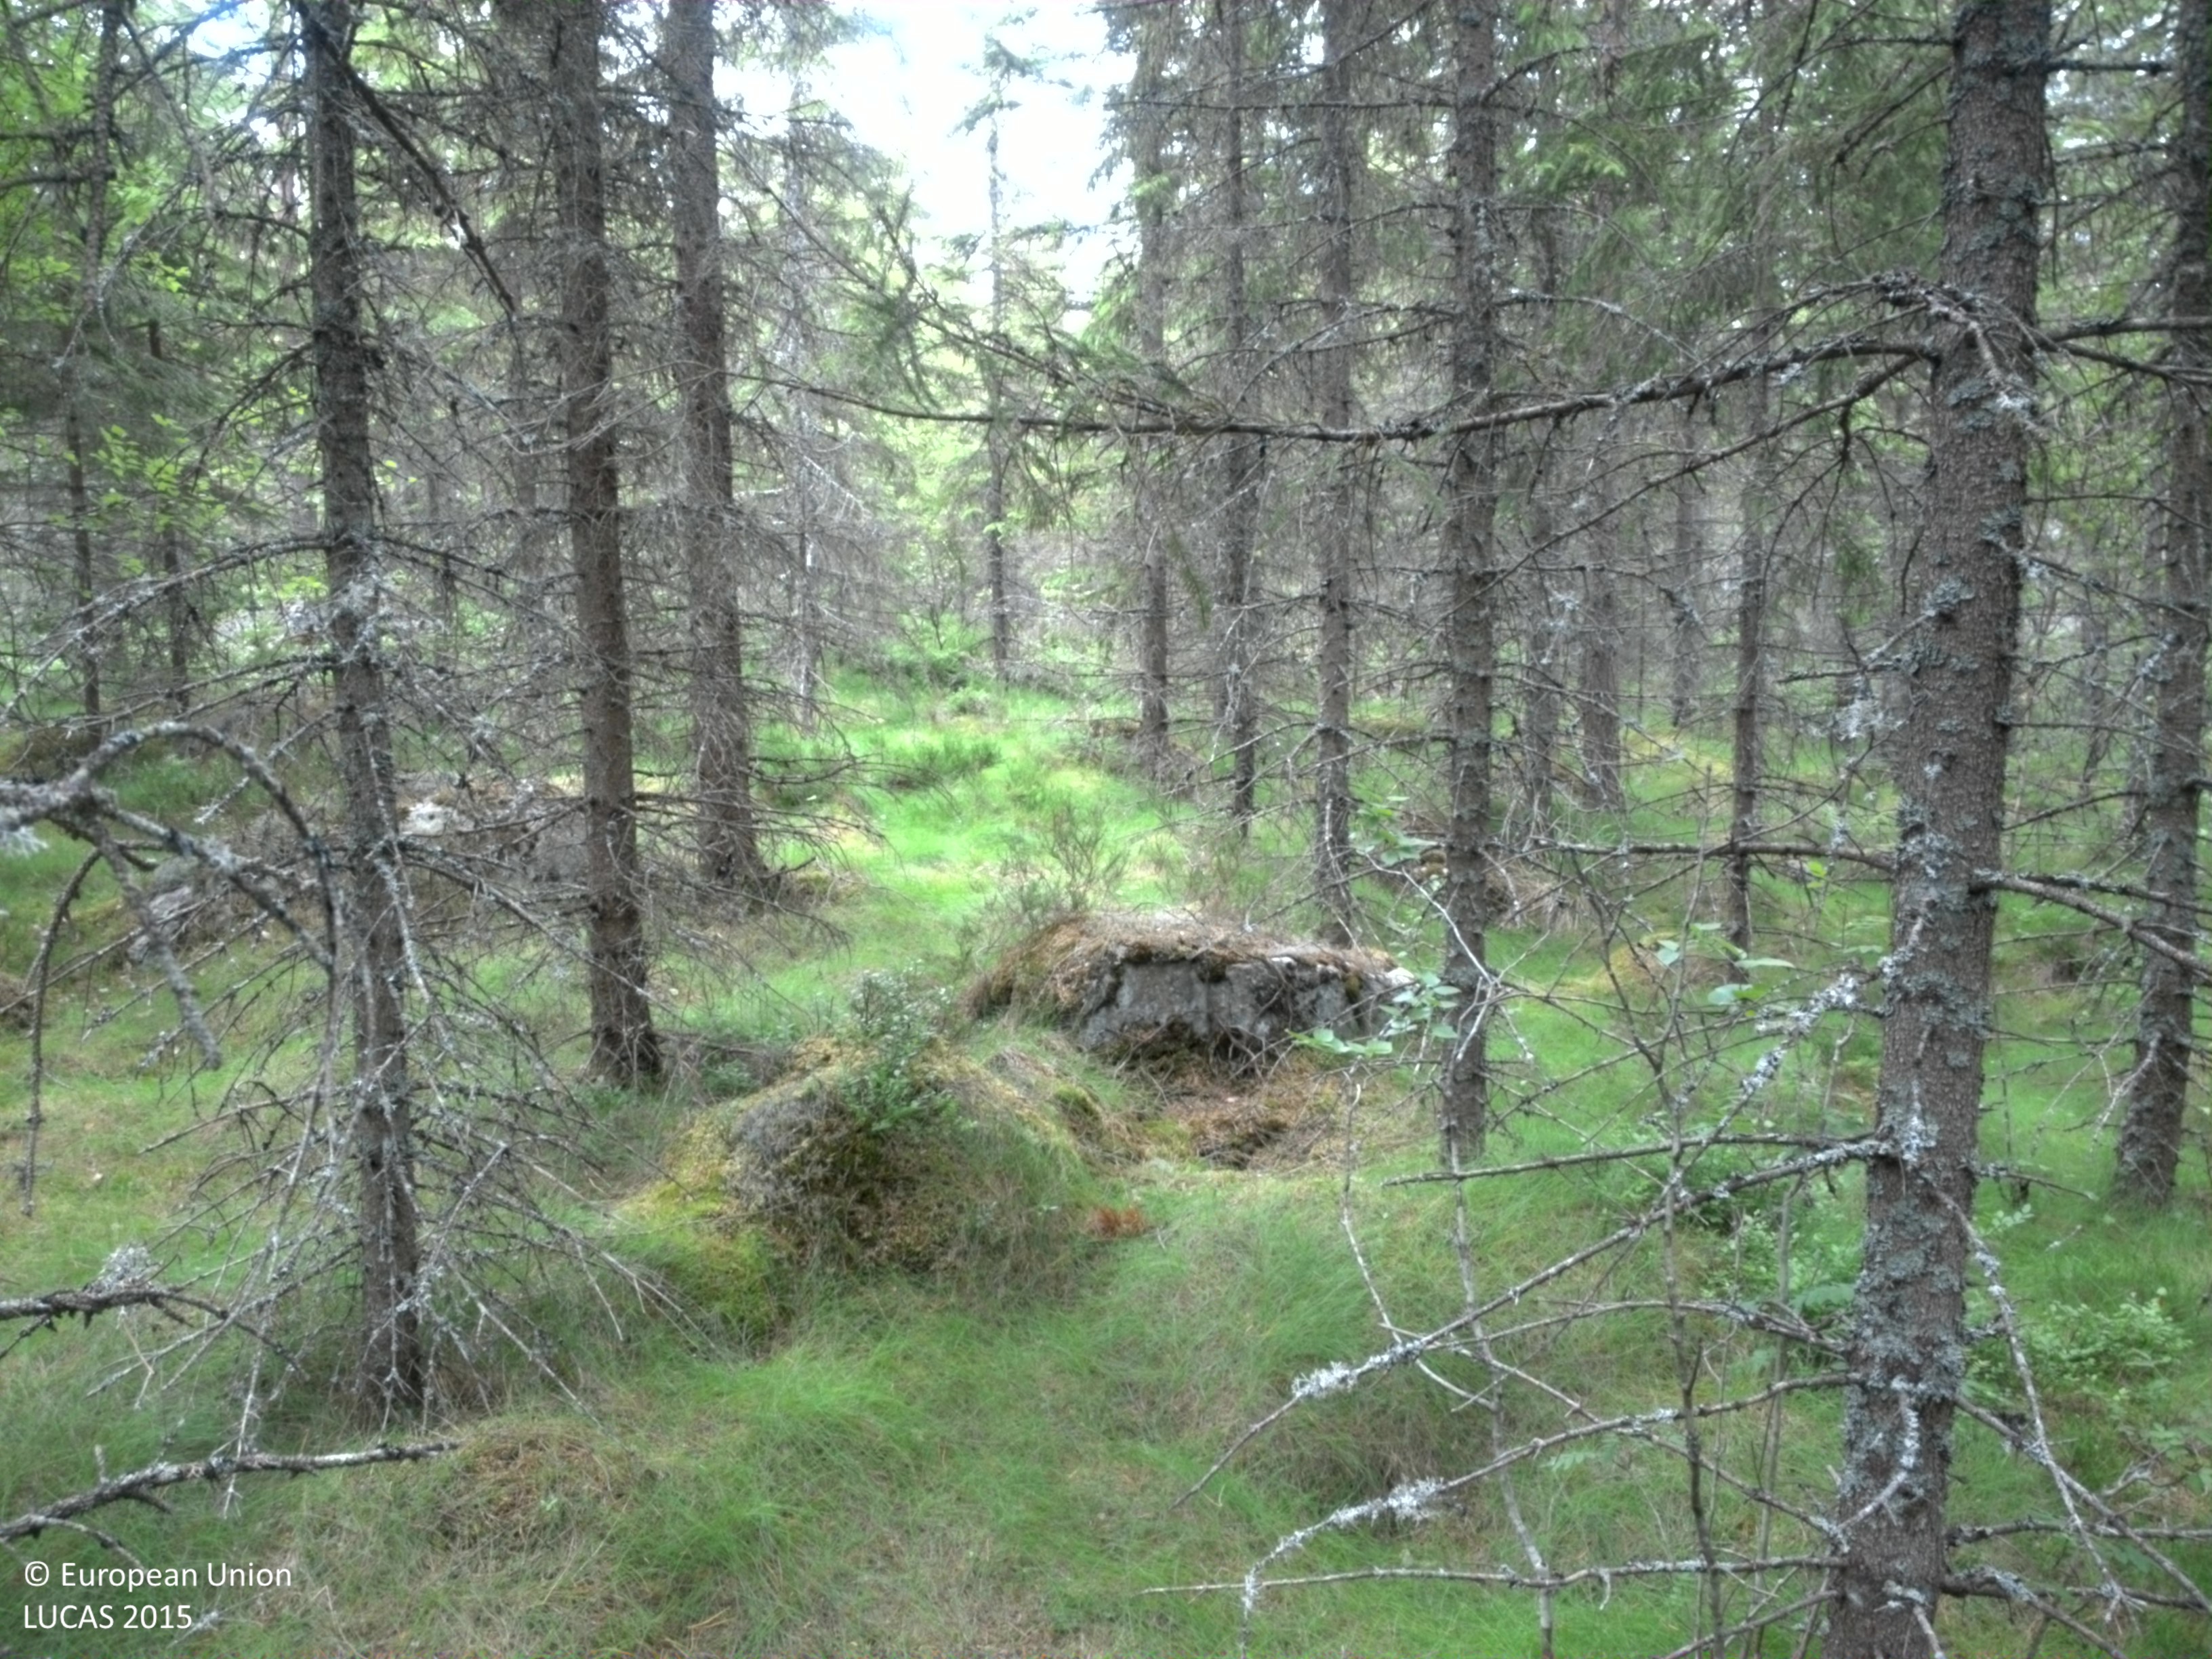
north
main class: Woodland
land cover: Spruce dominated mixed woodland
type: boreal forest
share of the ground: 50 - 75 %
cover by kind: coniferous forest trees 50 %, broadleaved forest trees 20 %, shrubs 10 %, herbaceous plants 10 %, lichens and mosses 5 %, consolidated bare surface 5 %
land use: Forestry
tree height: > 5 m
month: July
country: SE
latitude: 59.5285
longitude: 14.6051
